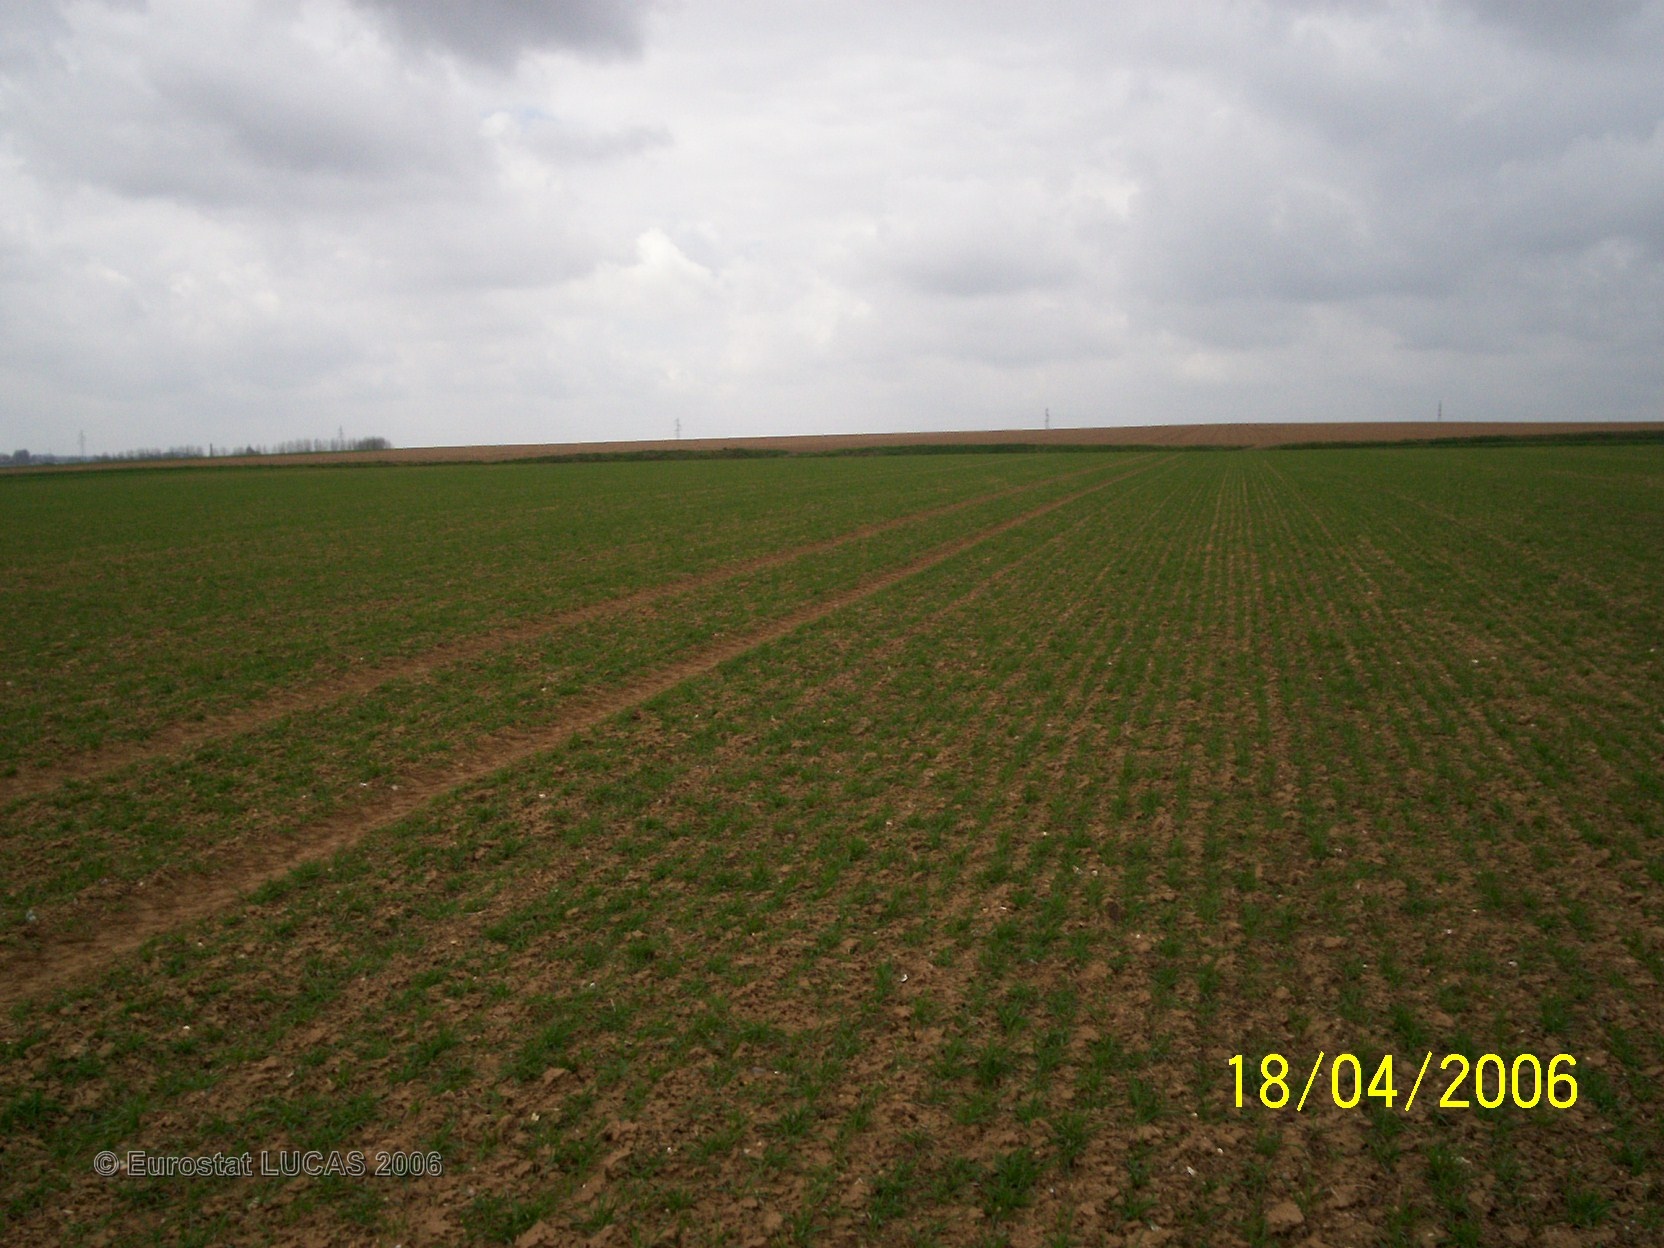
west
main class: Cropland
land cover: Common wheat
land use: Agriculture (excluding fallow land and kitchen gardens)
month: April
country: FR
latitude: 50.3595
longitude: 2.6083
